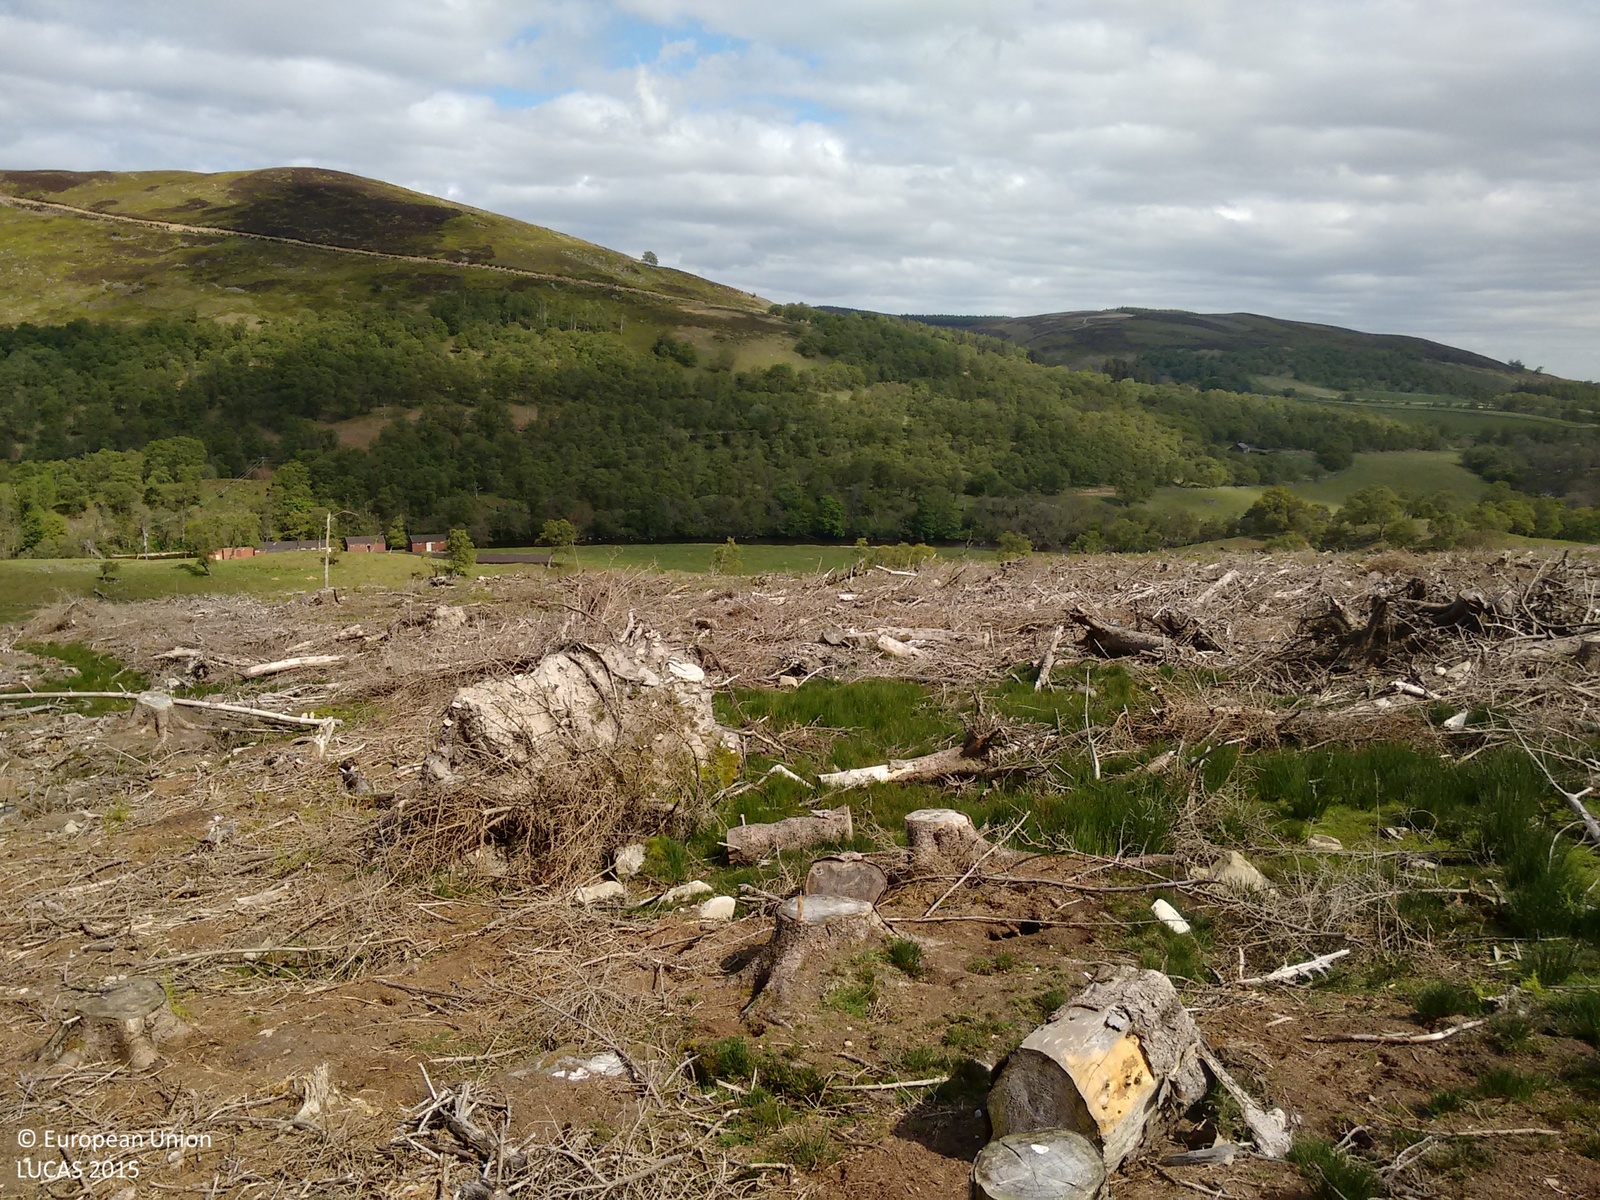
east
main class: Grassland
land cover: Spontaneously vegetated surfaces
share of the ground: 25 - 50 %
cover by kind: herbaceous plants 20 %, unconsolidated bare surface 10 %
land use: Forestry
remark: Clear cut
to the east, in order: Spontaneously vegetated surfaces; Grassland without tree/shrub cover; Tracks; Spontaneously vegetated surfaces; Tracks; Spontaneously vegetated surfaces; Tracks; Spontaneously vegetated surfaces; Tracks; Grassland without tree/shrub cover; Single bushes/trees; Fences; Grassland without tree/shrub cover; Other bare soil
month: May
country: GB
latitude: 56.8655
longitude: -2.7062
